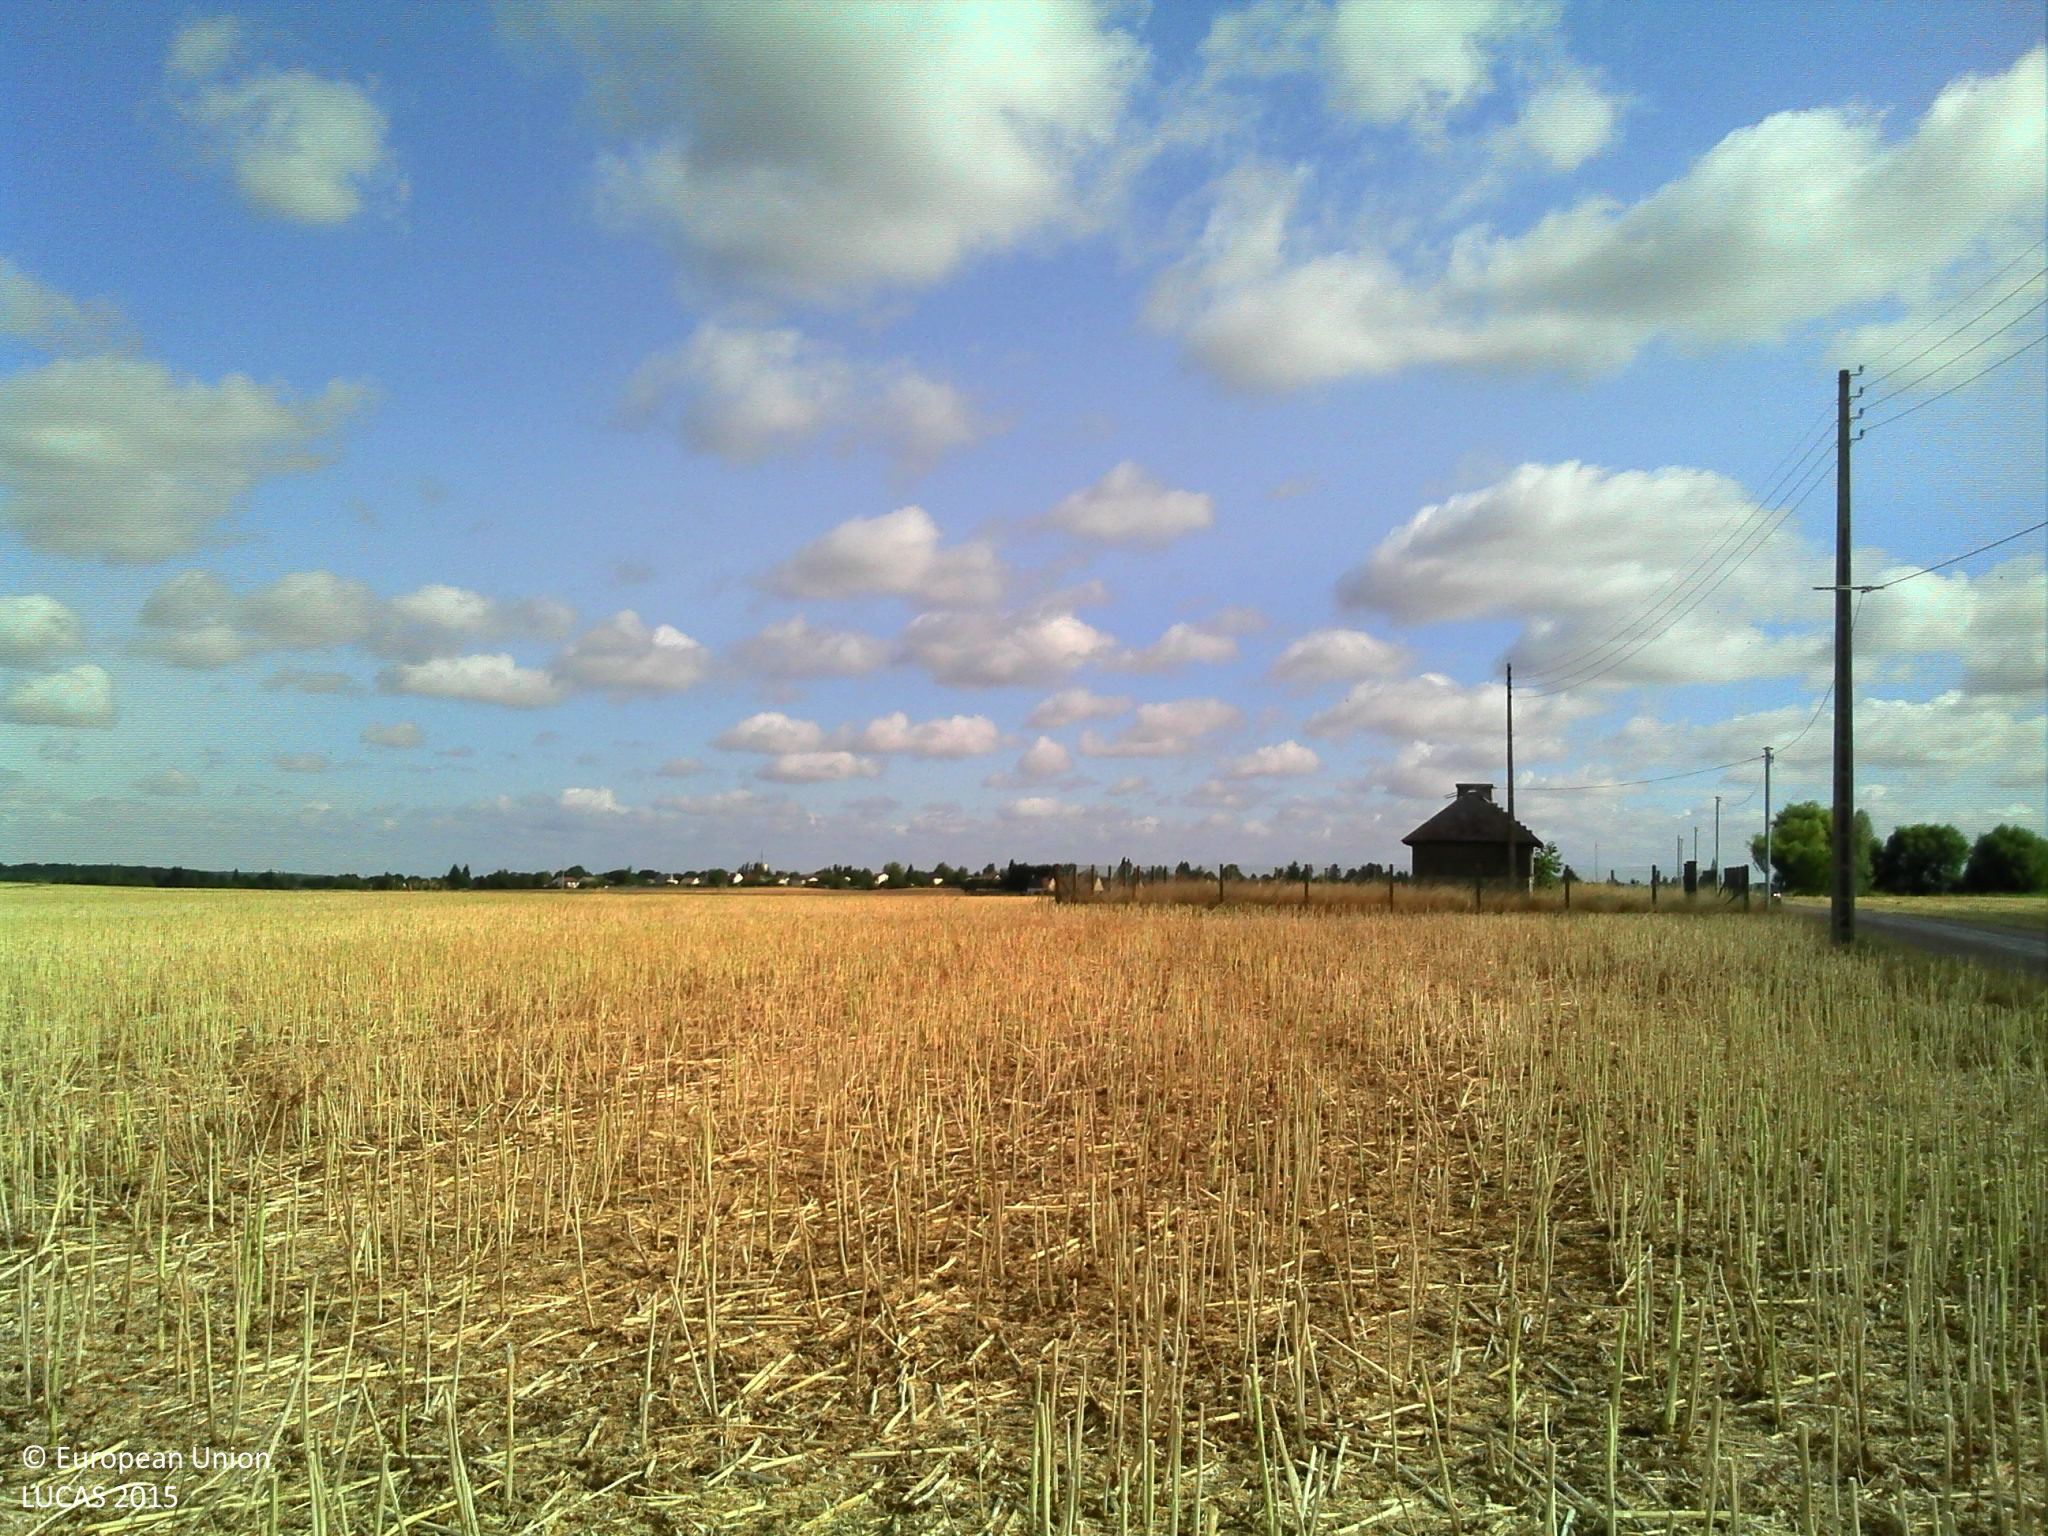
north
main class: Cropland
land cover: Rape and turnip rape
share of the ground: > 75 %
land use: Agriculture (excluding fallow land and kitchen gardens)
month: July
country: FR
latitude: 48.0772
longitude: 2.7838
